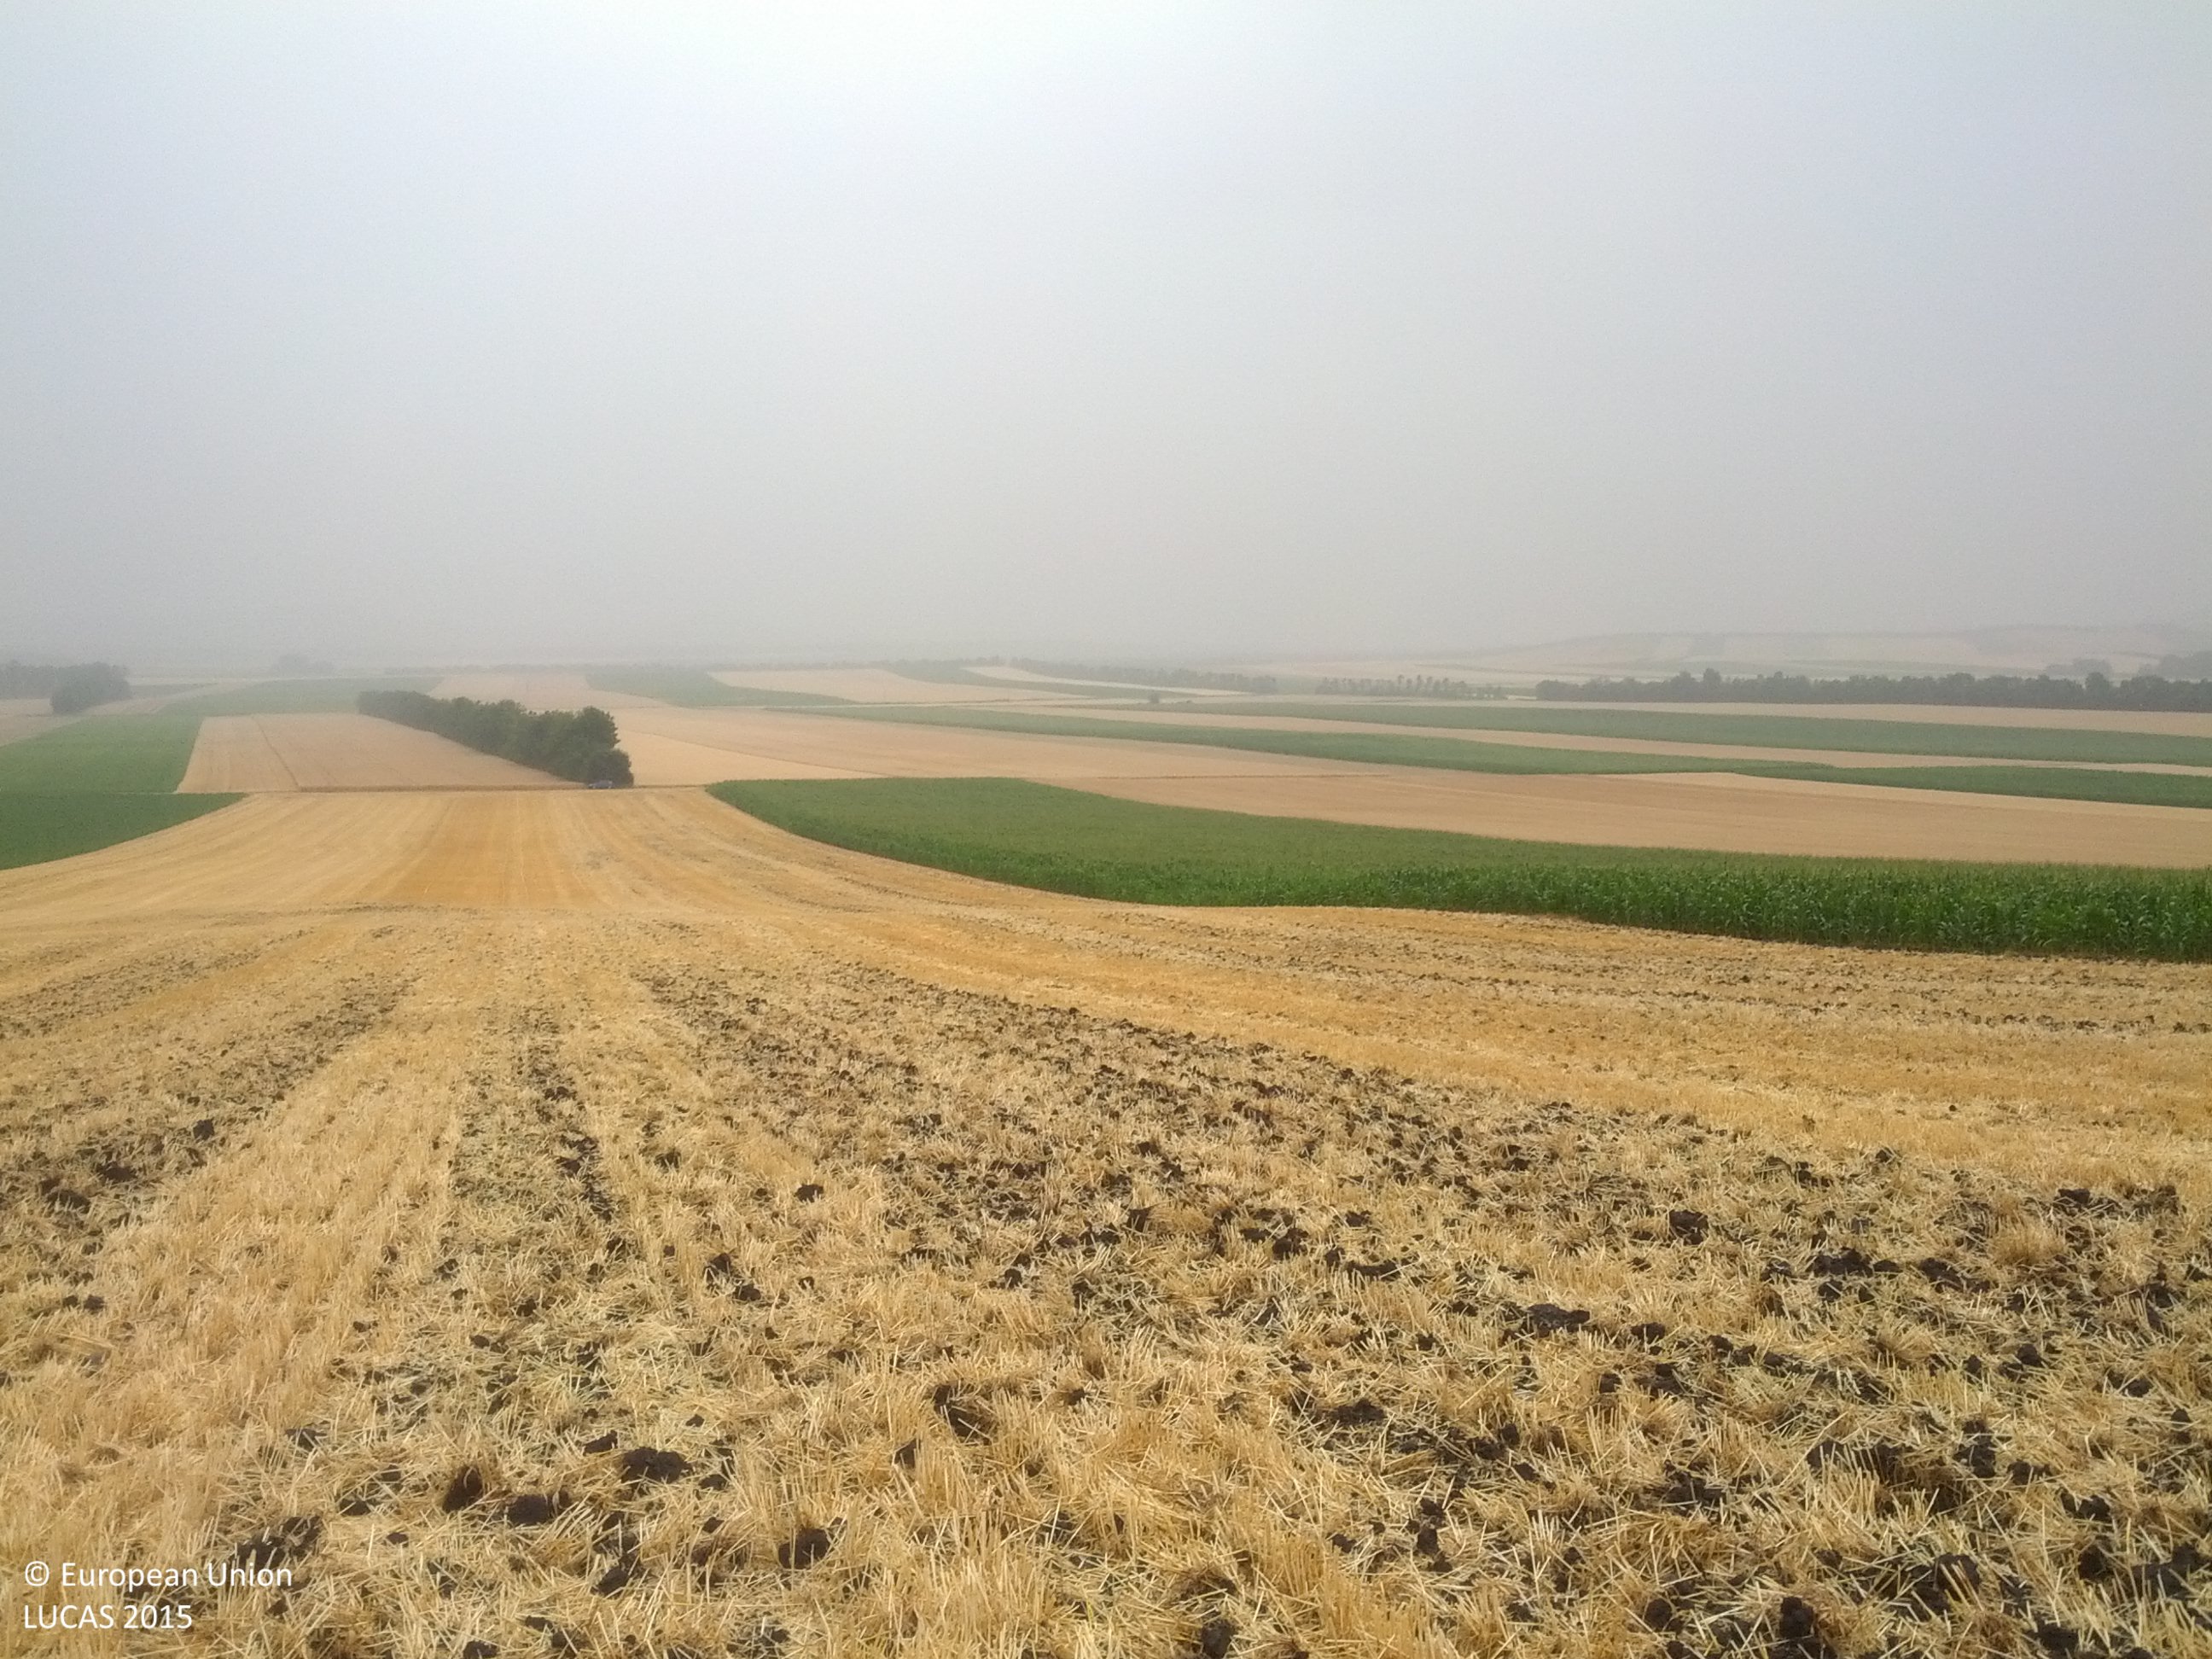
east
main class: Cropland
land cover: Barley
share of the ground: < 10 %
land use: Agriculture (excluding fallow land and kitchen gardens)
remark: Harvested field
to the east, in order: Barley; Maize
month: July
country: AT
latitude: 48.7882
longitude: 16.5263
